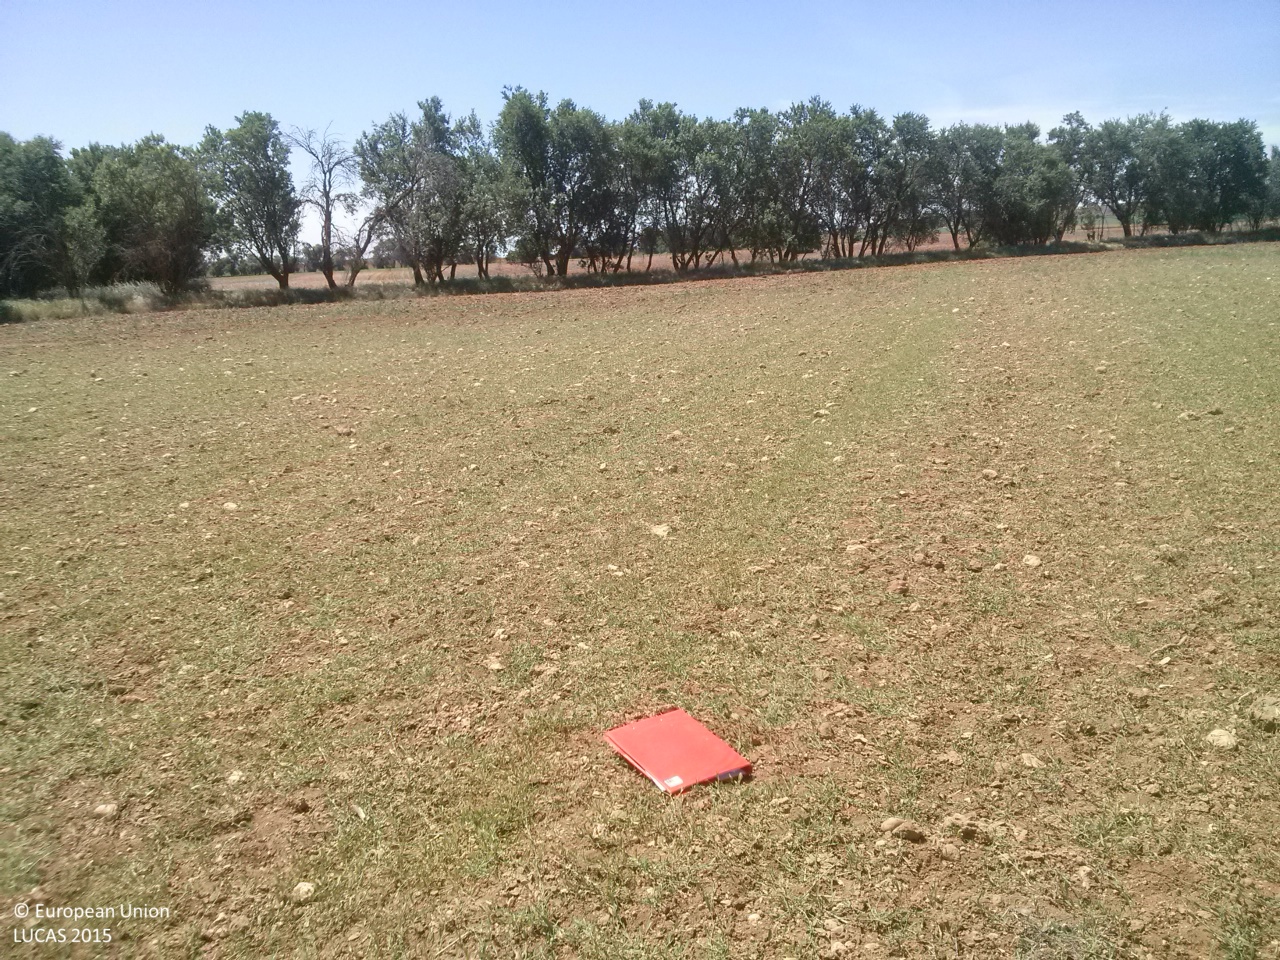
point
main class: Grassland
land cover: Spontaneously vegetated surfaces
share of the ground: 25 - 50 %
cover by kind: unconsolidated bare surface 60 %, herbaceous plants 40 %
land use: Fallow land
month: May
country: ES
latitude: 39.9389
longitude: -2.7883
